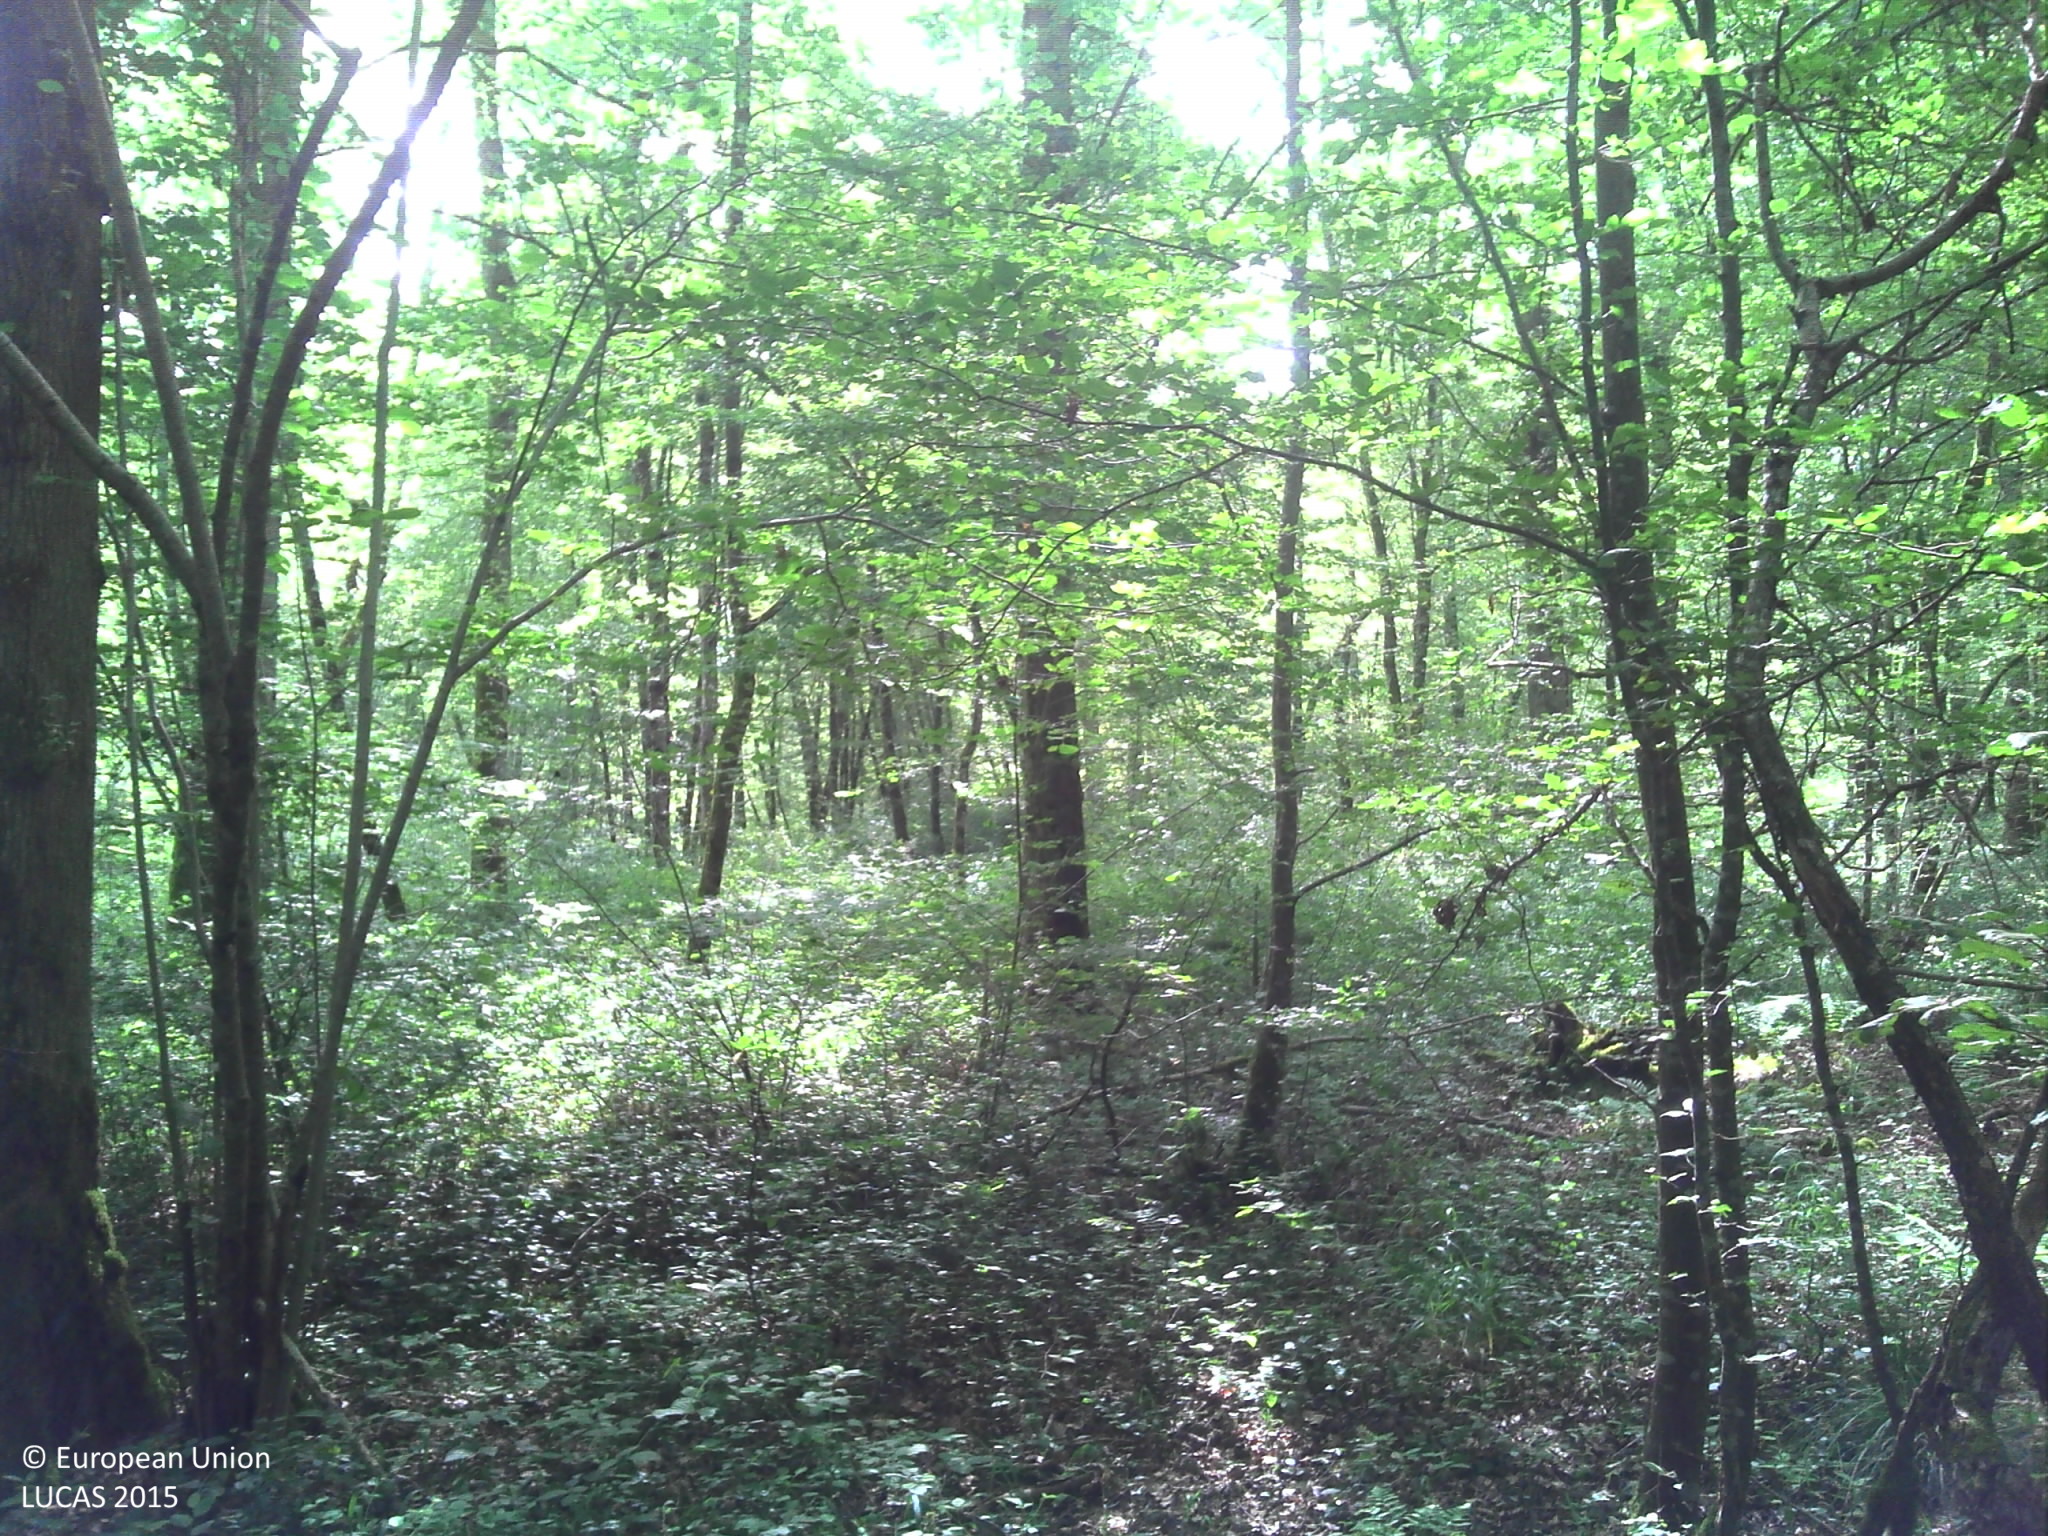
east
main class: Woodland
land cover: Broadleaved woodland
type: mesophytic deciduous forest
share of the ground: > 75 %
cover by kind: broadleaved forest trees 95 %, herbaceous plants 5 %
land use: Forestry
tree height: > 5 m
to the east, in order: Broadleaved woodland; Ditches and canals; Broadleaved woodland
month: June
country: FR
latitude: 46.8989
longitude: 2.9996
